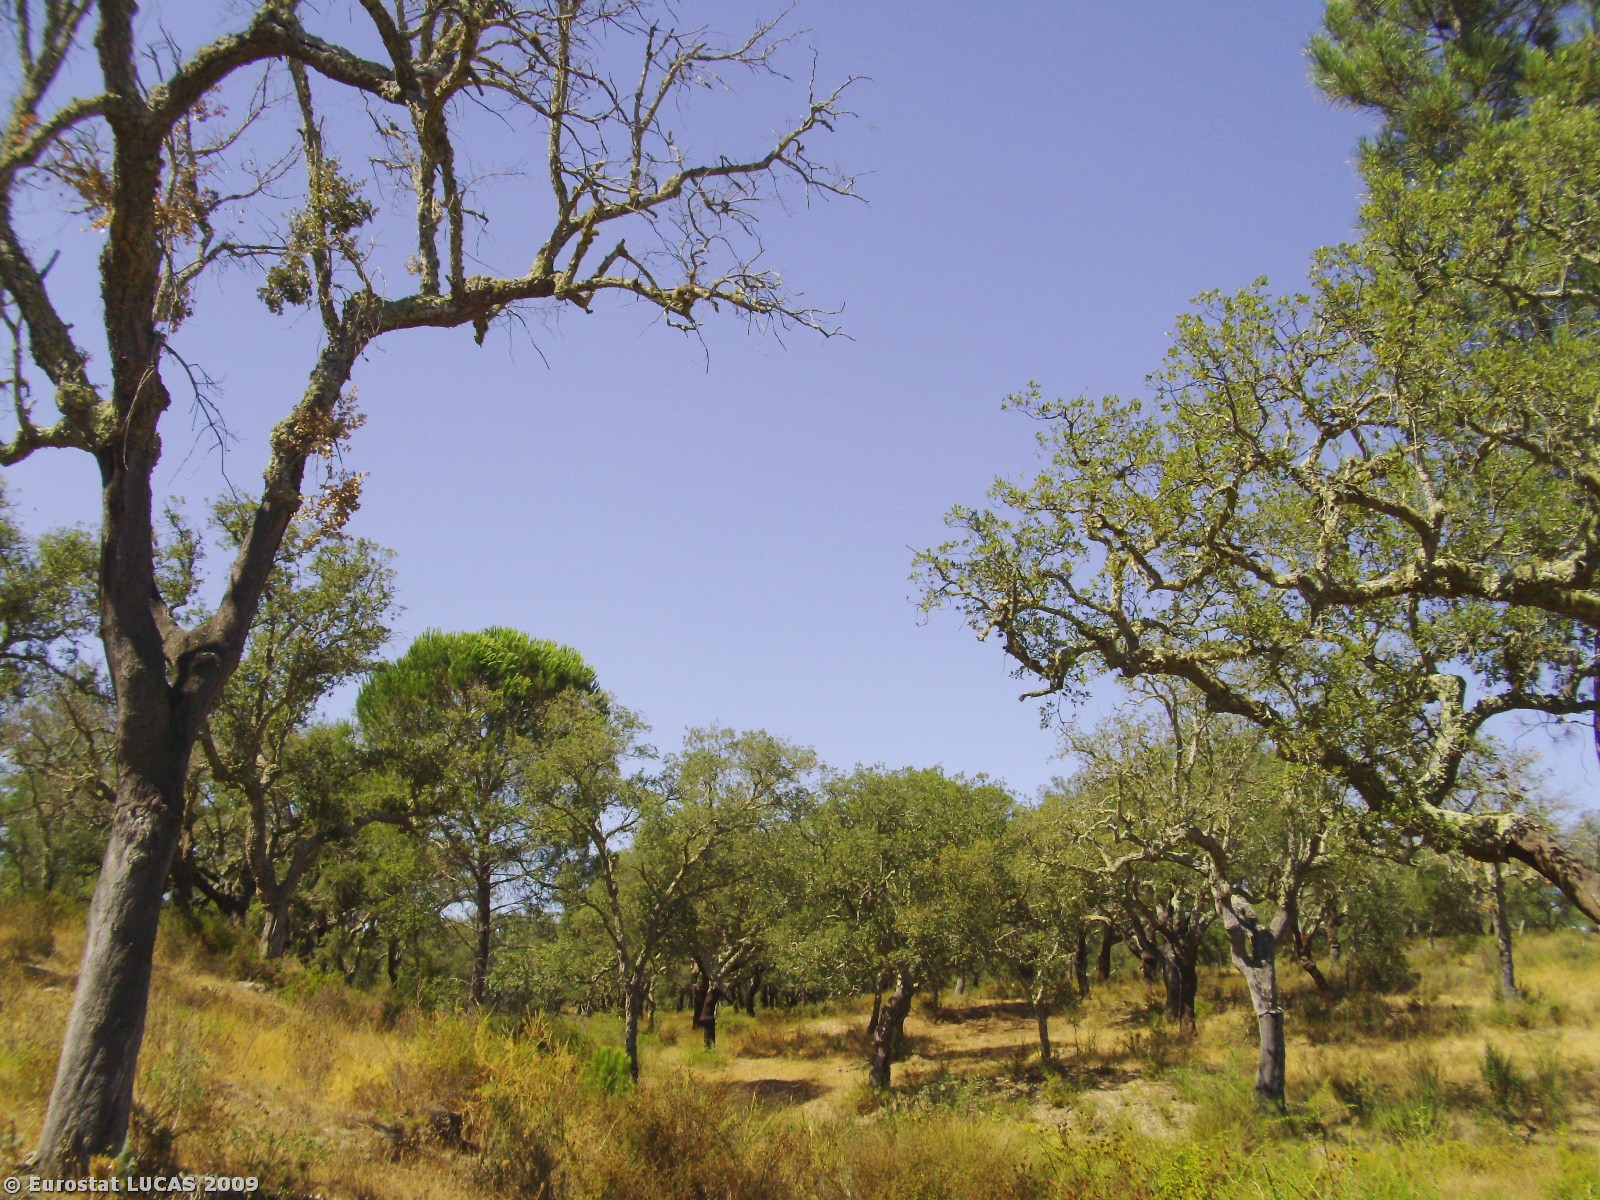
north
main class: Woodland
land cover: Broadleaved woodland
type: broadleaved evergreen forest
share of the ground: 50 - 75 %
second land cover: Spontaneously vegetated surfaces
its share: 50 - 75 %
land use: Forestry
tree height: > 5 m
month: July
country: PT
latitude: 38.3151
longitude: -8.4505
